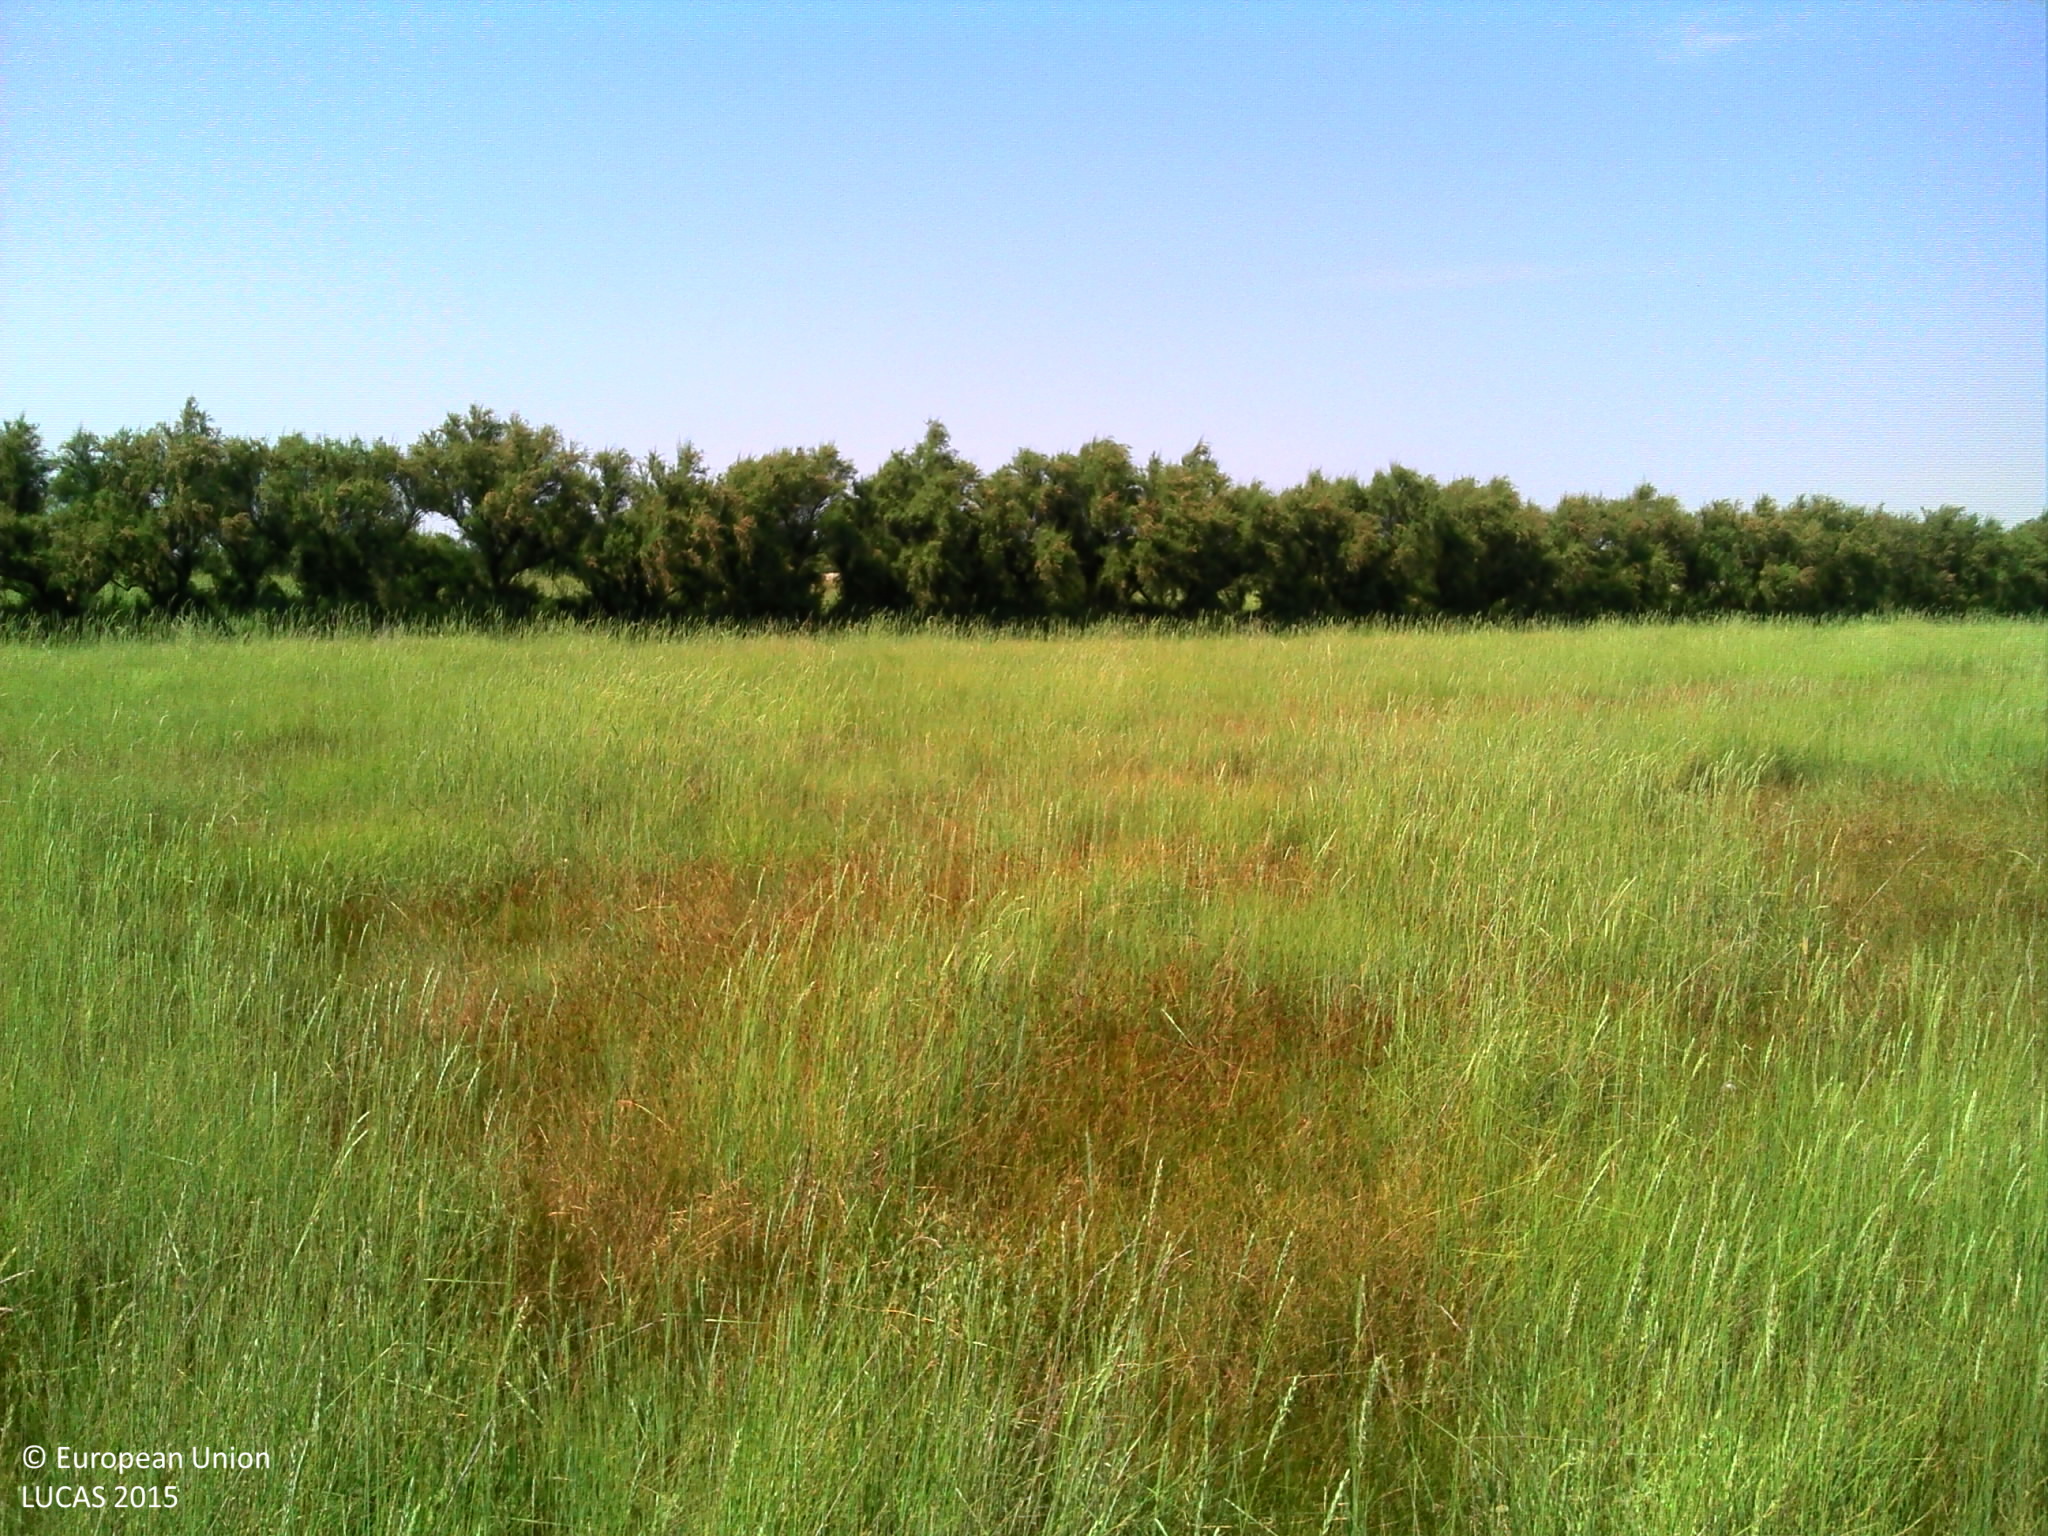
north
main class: Grassland
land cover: Grassland without tree/shrub cover
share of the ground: > 75 %
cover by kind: herbaceous plants 100 %
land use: Agriculture (excluding fallow land and kitchen gardens)
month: June
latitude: 45.6958
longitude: -0.9560
